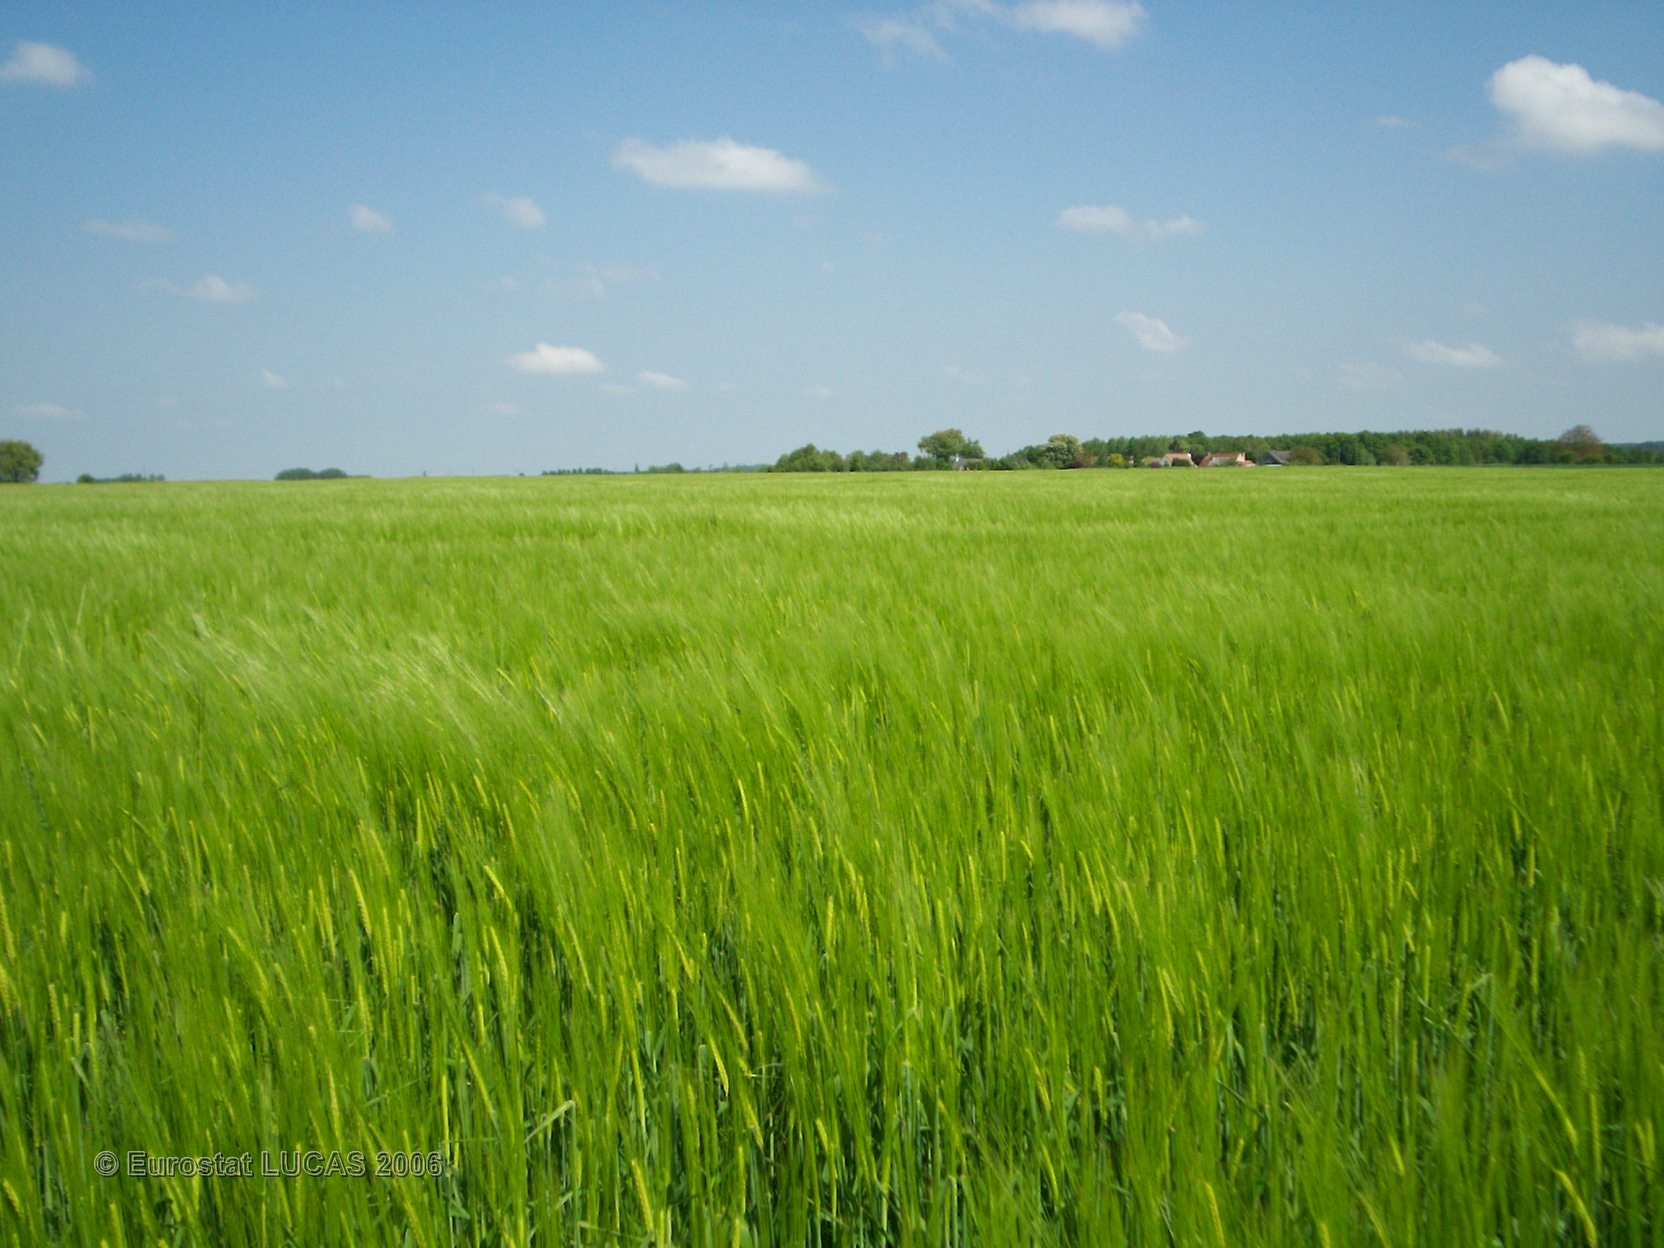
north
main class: Cropland
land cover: Barley
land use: Agriculture (excluding fallow land and kitchen gardens)
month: May
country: FR
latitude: 47.4014
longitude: 0.1573
